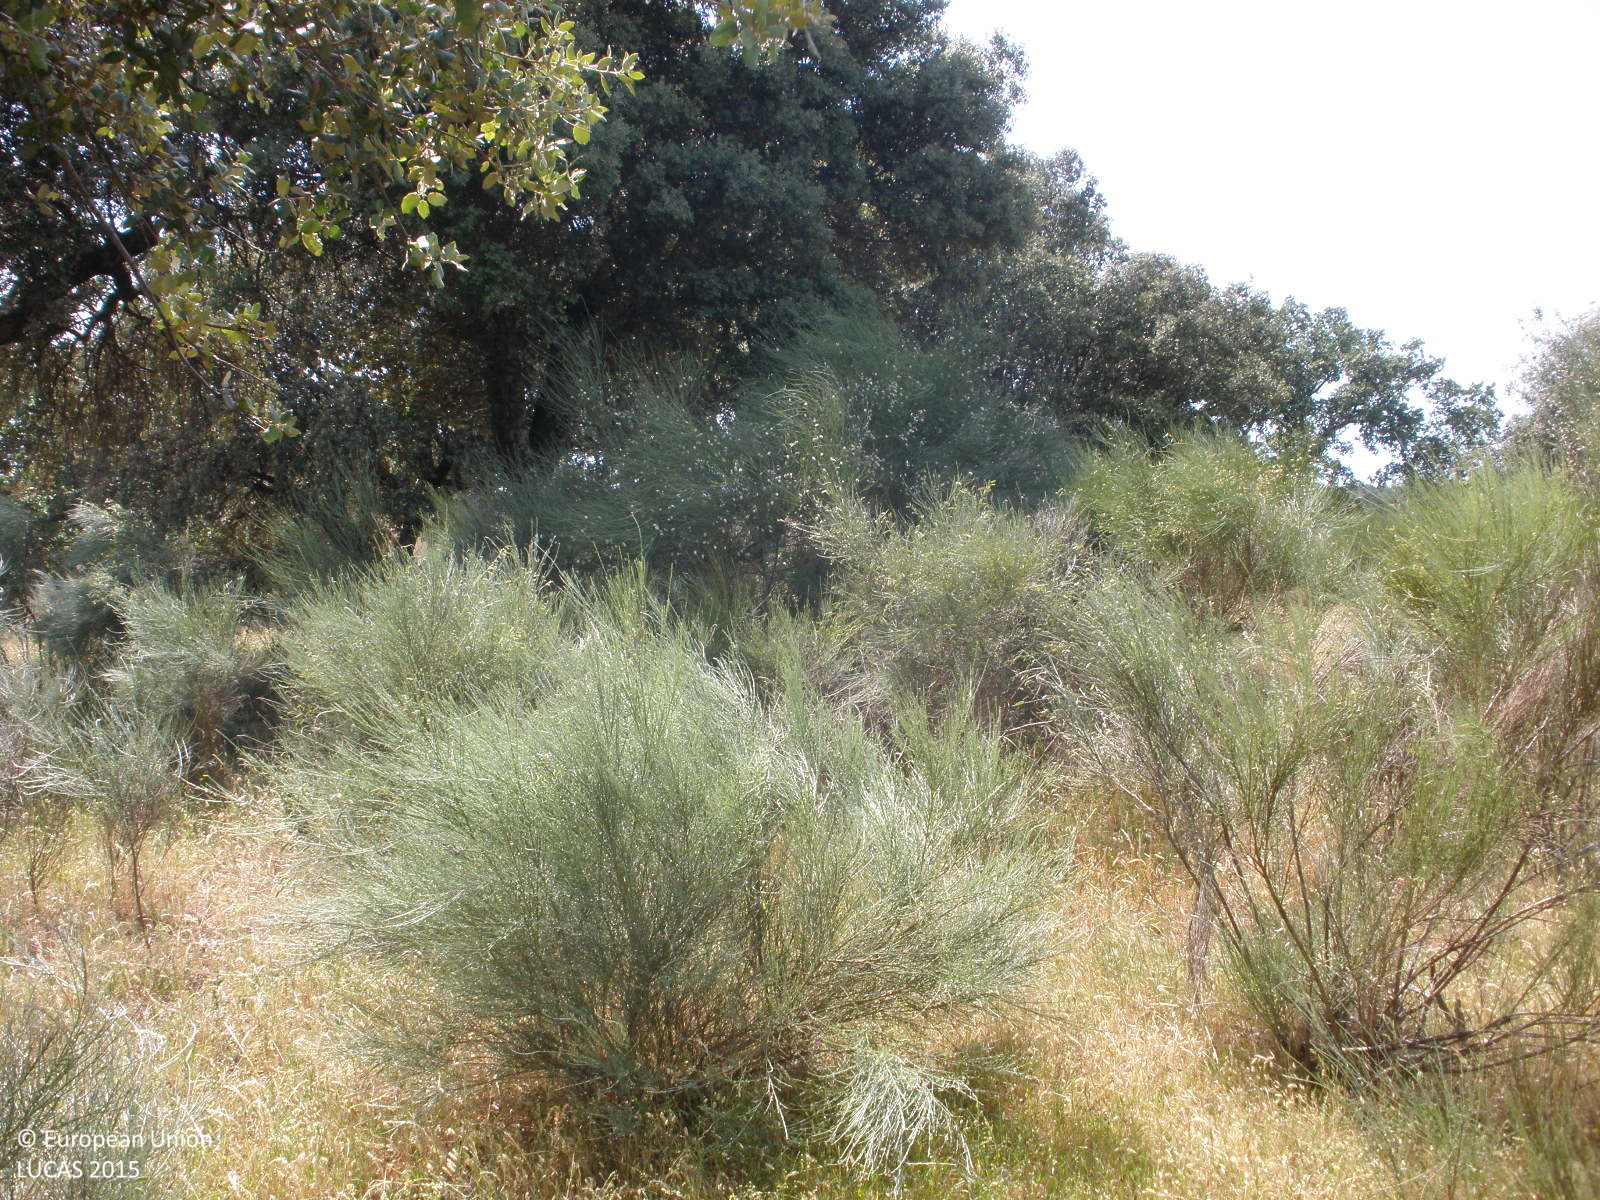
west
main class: Woodland
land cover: Broadleaved woodland
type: broadleaved evergreen forest
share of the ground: 50 - 75 %
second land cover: Grassland without tree/shrub cover
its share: > 75 %
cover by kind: herbaceous plants 60 %, broadleaved forest trees 40 %
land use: Forestry
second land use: Agriculture (excluding fallow land and kitchen gardens)
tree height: > 5 m
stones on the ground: < 10 %
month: May
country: ES
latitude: 40.1499
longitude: -6.6008
